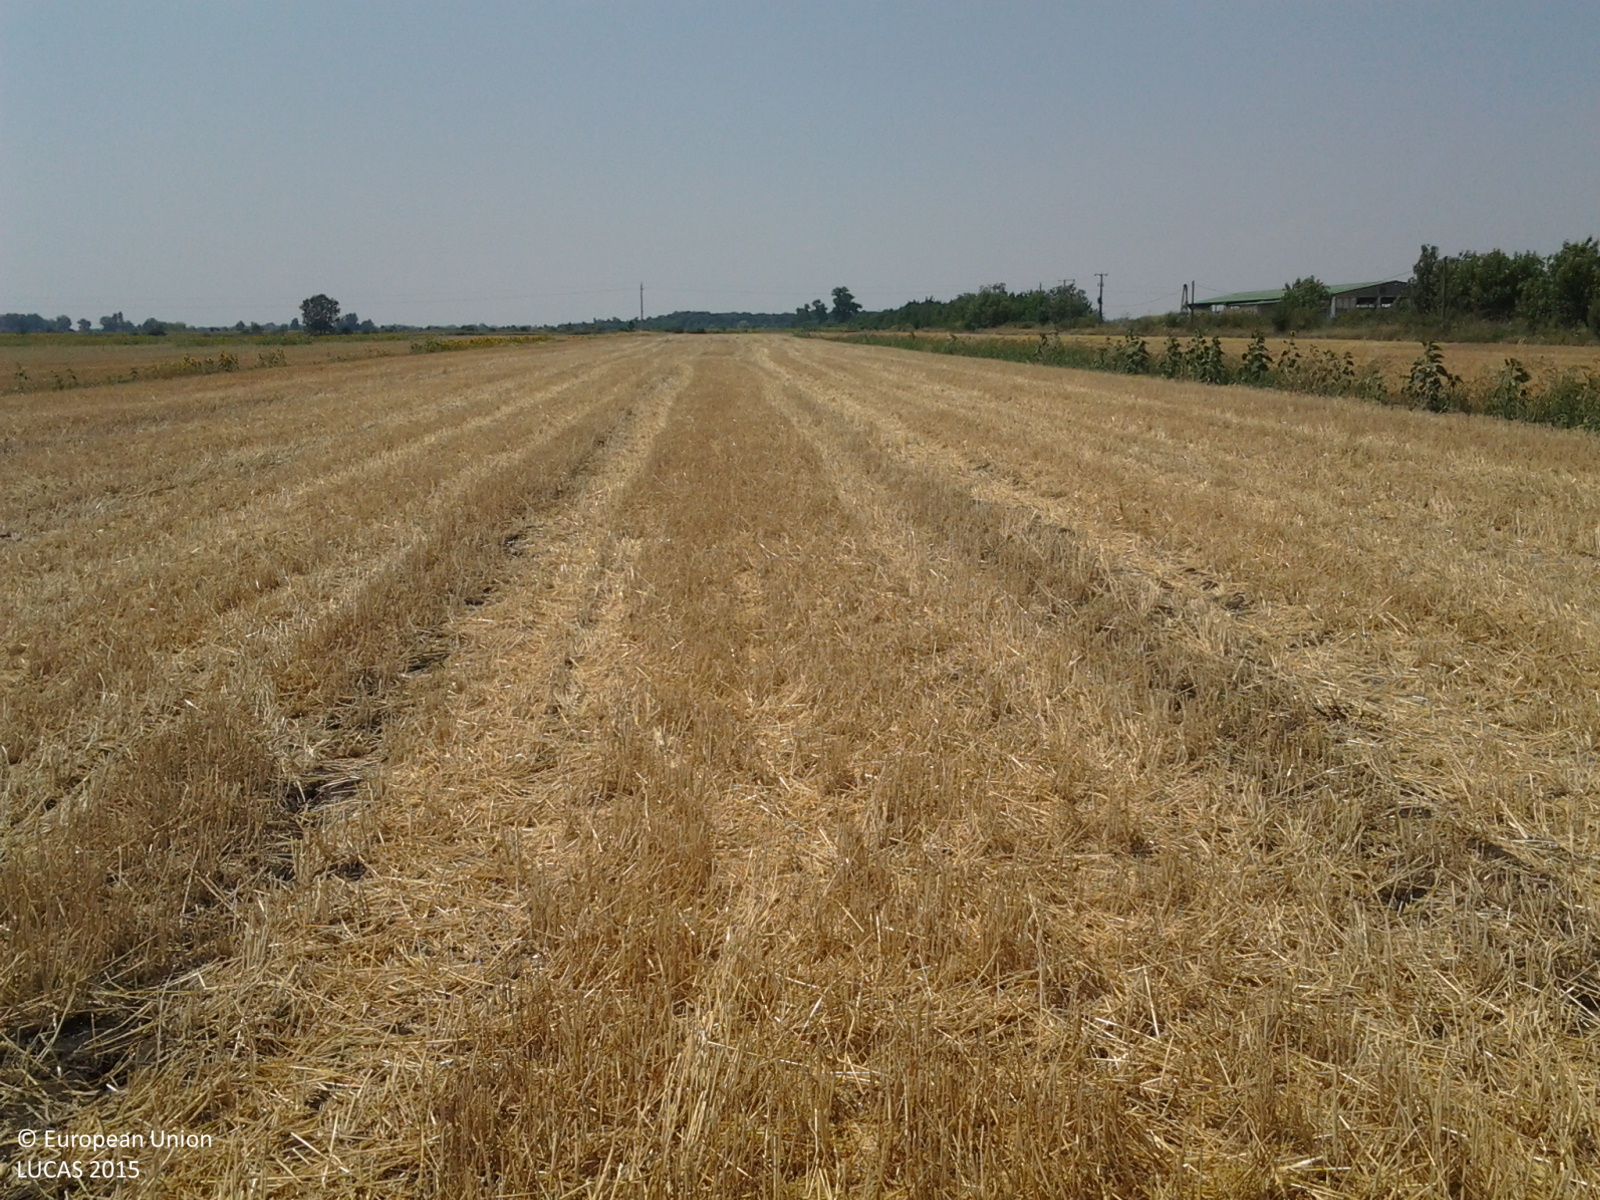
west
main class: Cropland
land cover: Common wheat
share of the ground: 10 - 25 %
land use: Agriculture (excluding fallow land and kitchen gardens)
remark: Harvested field
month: July
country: HU
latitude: 47.3676
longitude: 20.3979
